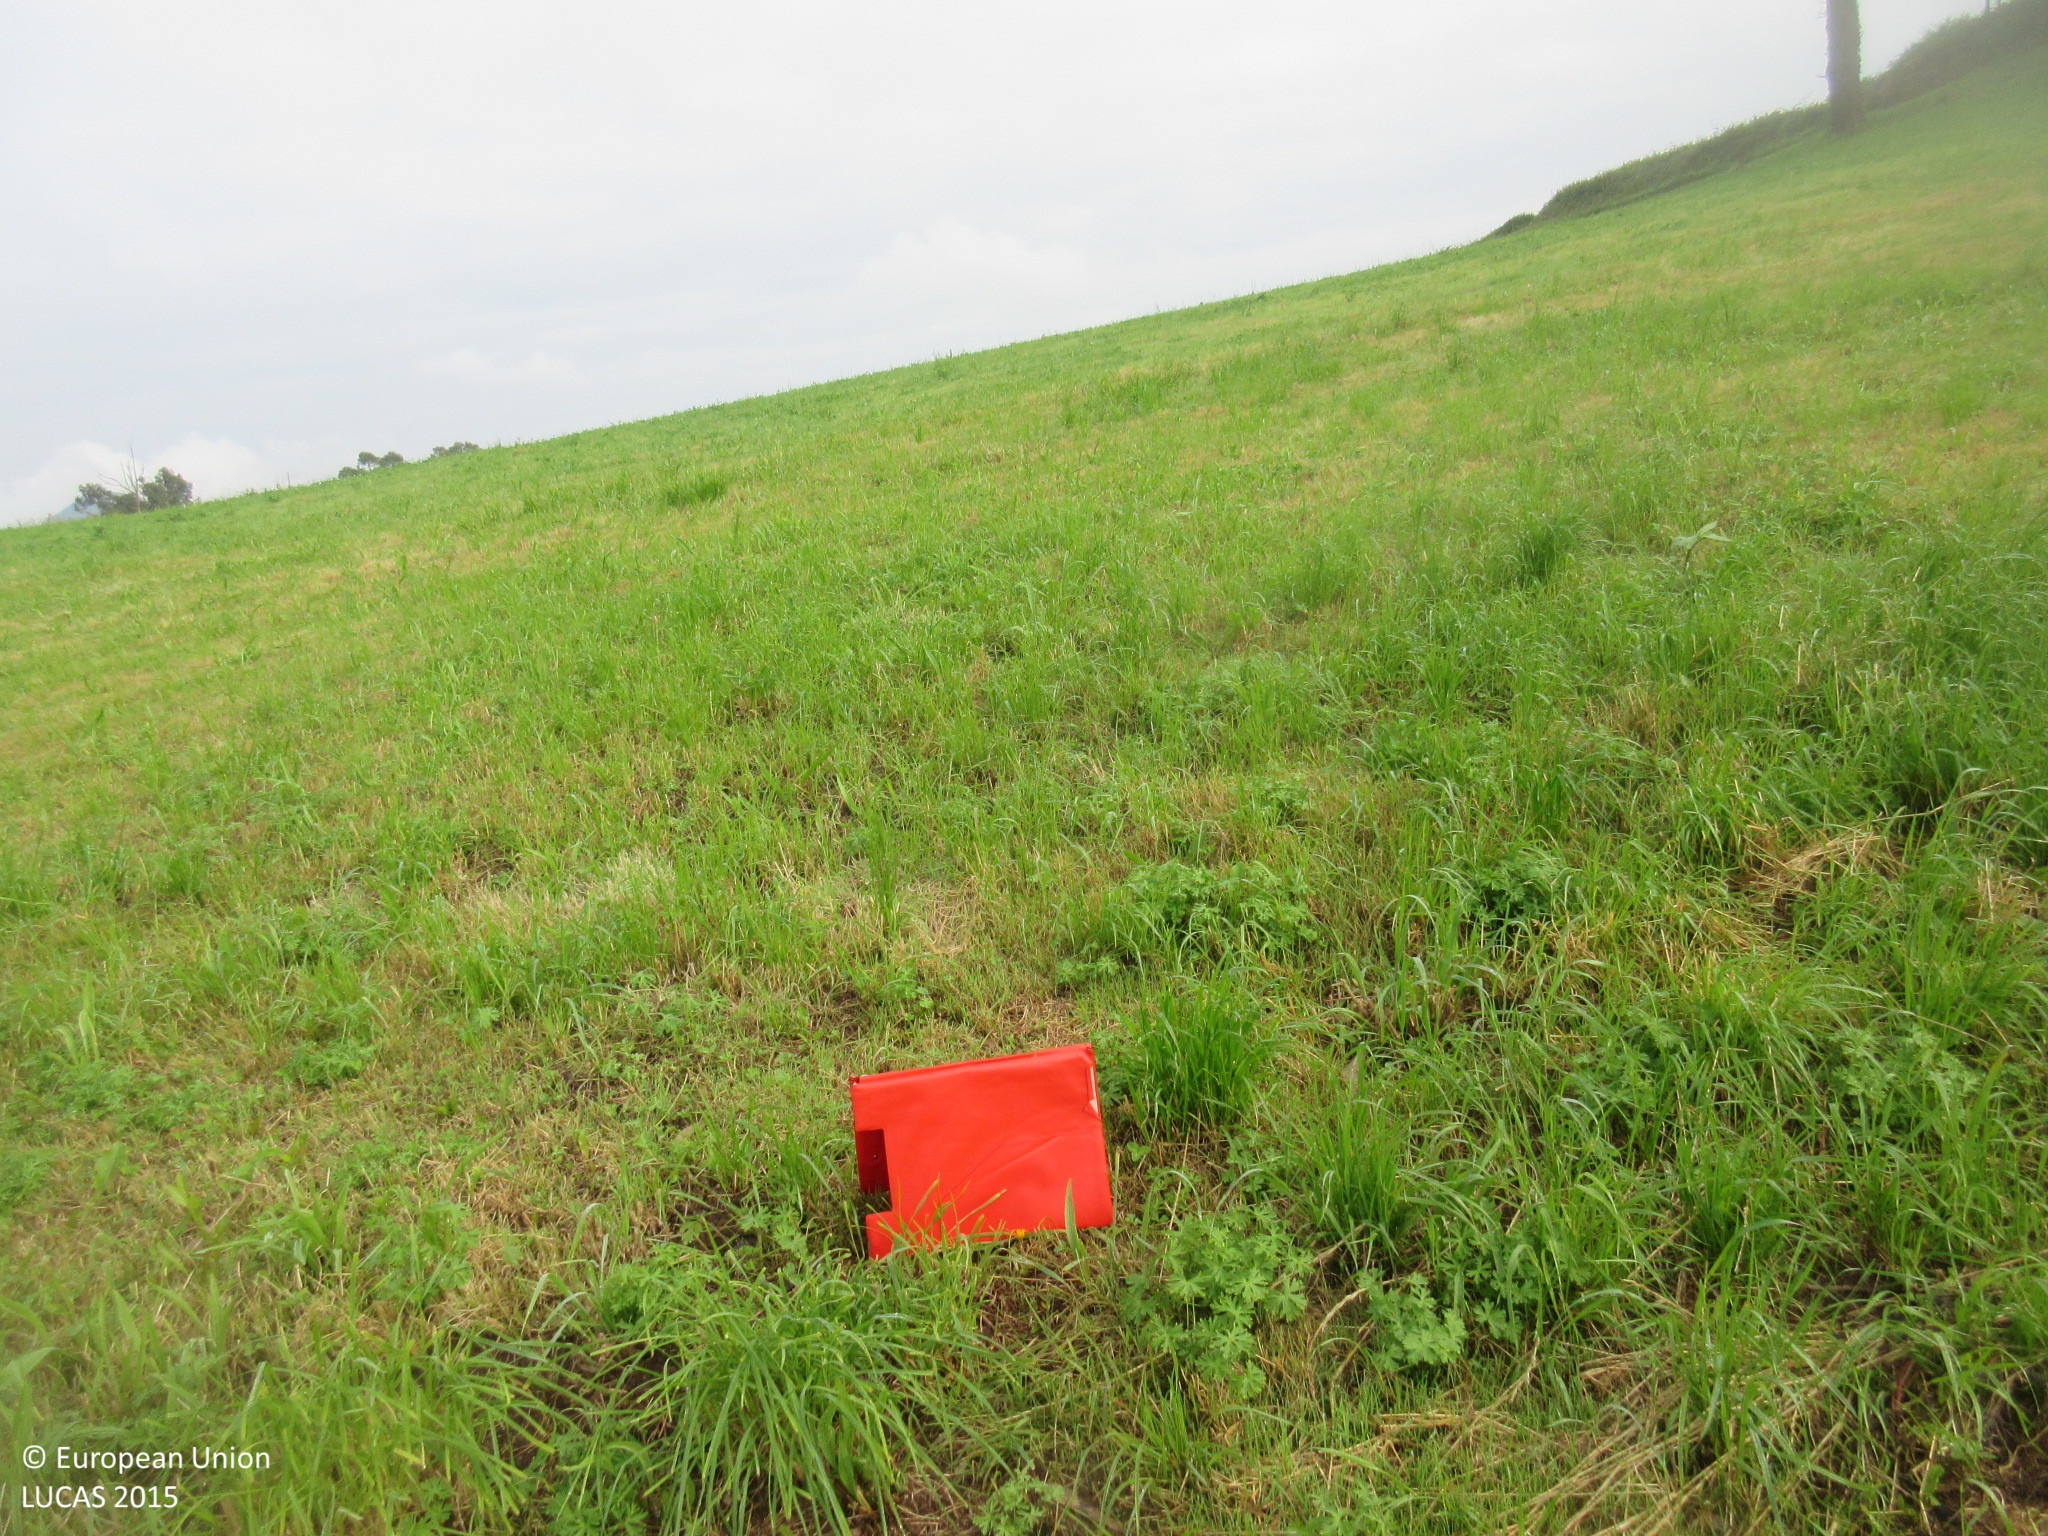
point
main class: Grassland
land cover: Grassland without tree/shrub cover
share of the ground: > 75 %
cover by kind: herbaceous plants 100 %
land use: Agriculture (excluding fallow land and kitchen gardens)
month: June
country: ES
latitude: 43.4642
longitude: -5.8986
